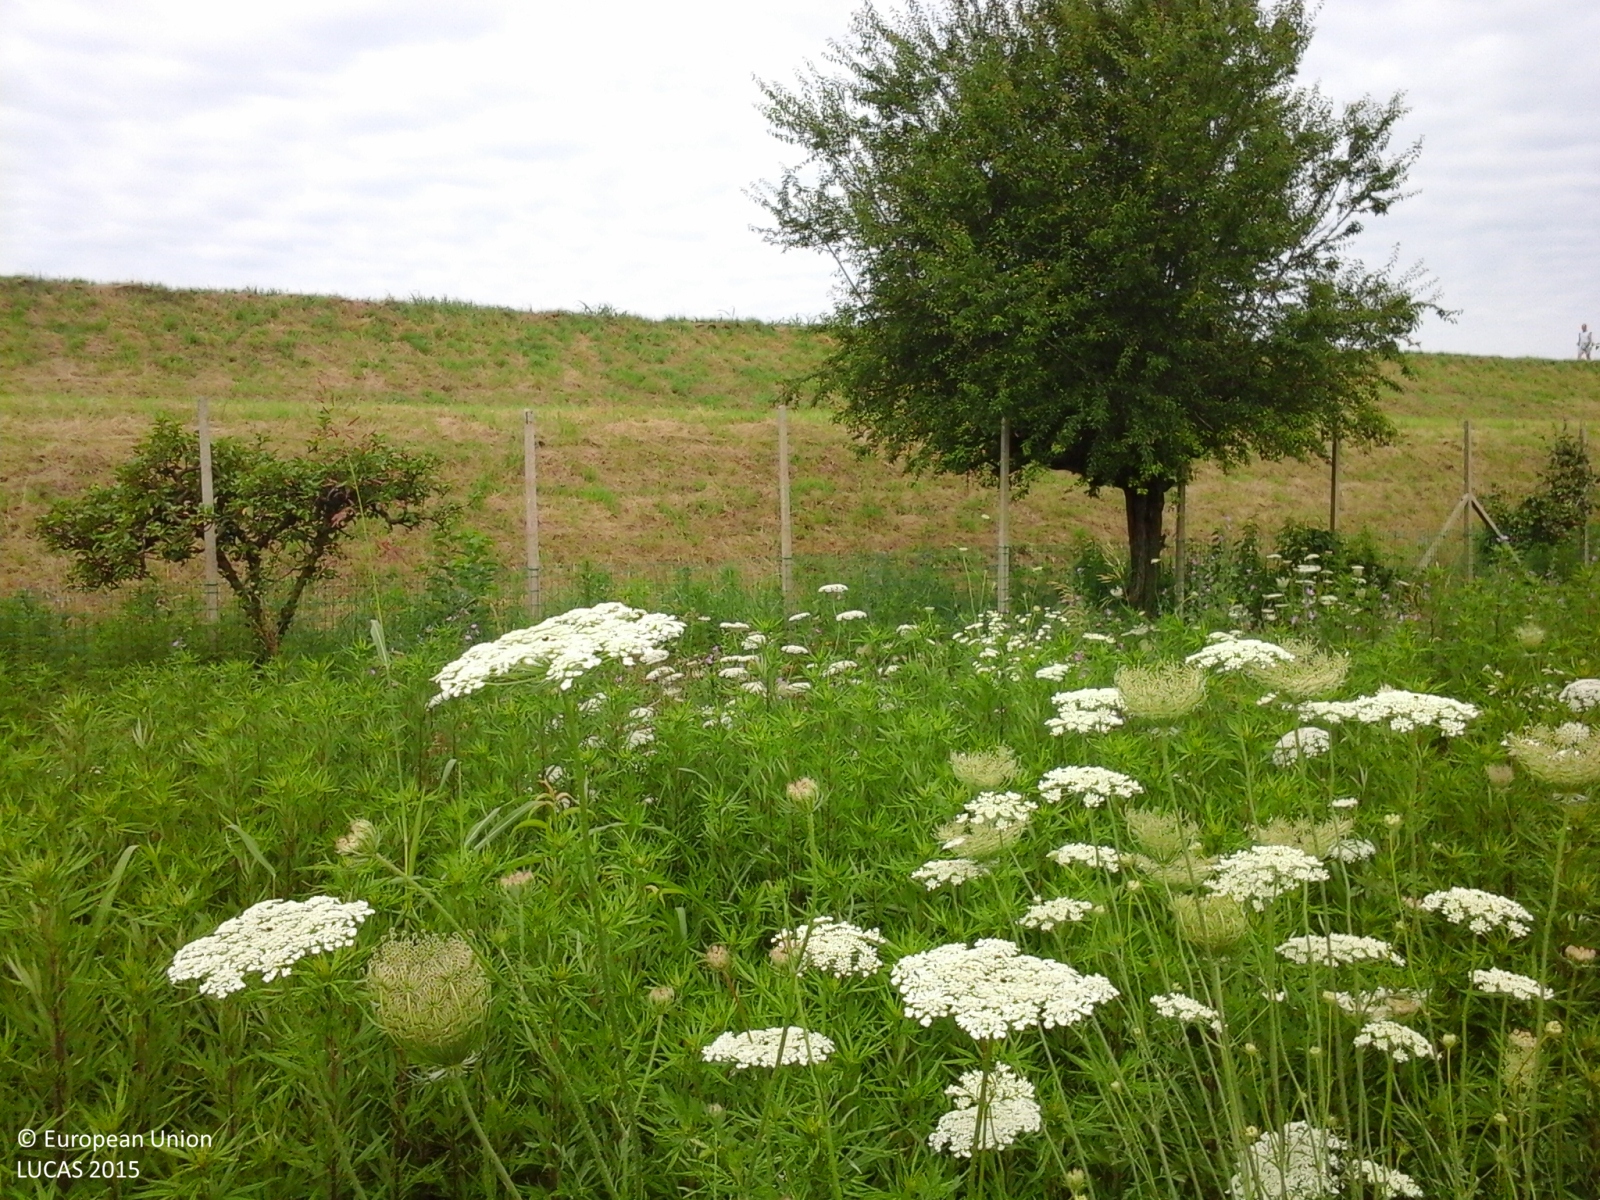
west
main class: Grassland
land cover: Spontaneously vegetated surfaces
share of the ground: > 75 %
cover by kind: herbaceous plants 100 %
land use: Fallow land
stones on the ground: < 10 %
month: June
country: IT
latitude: 45.6731
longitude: 12.4997
